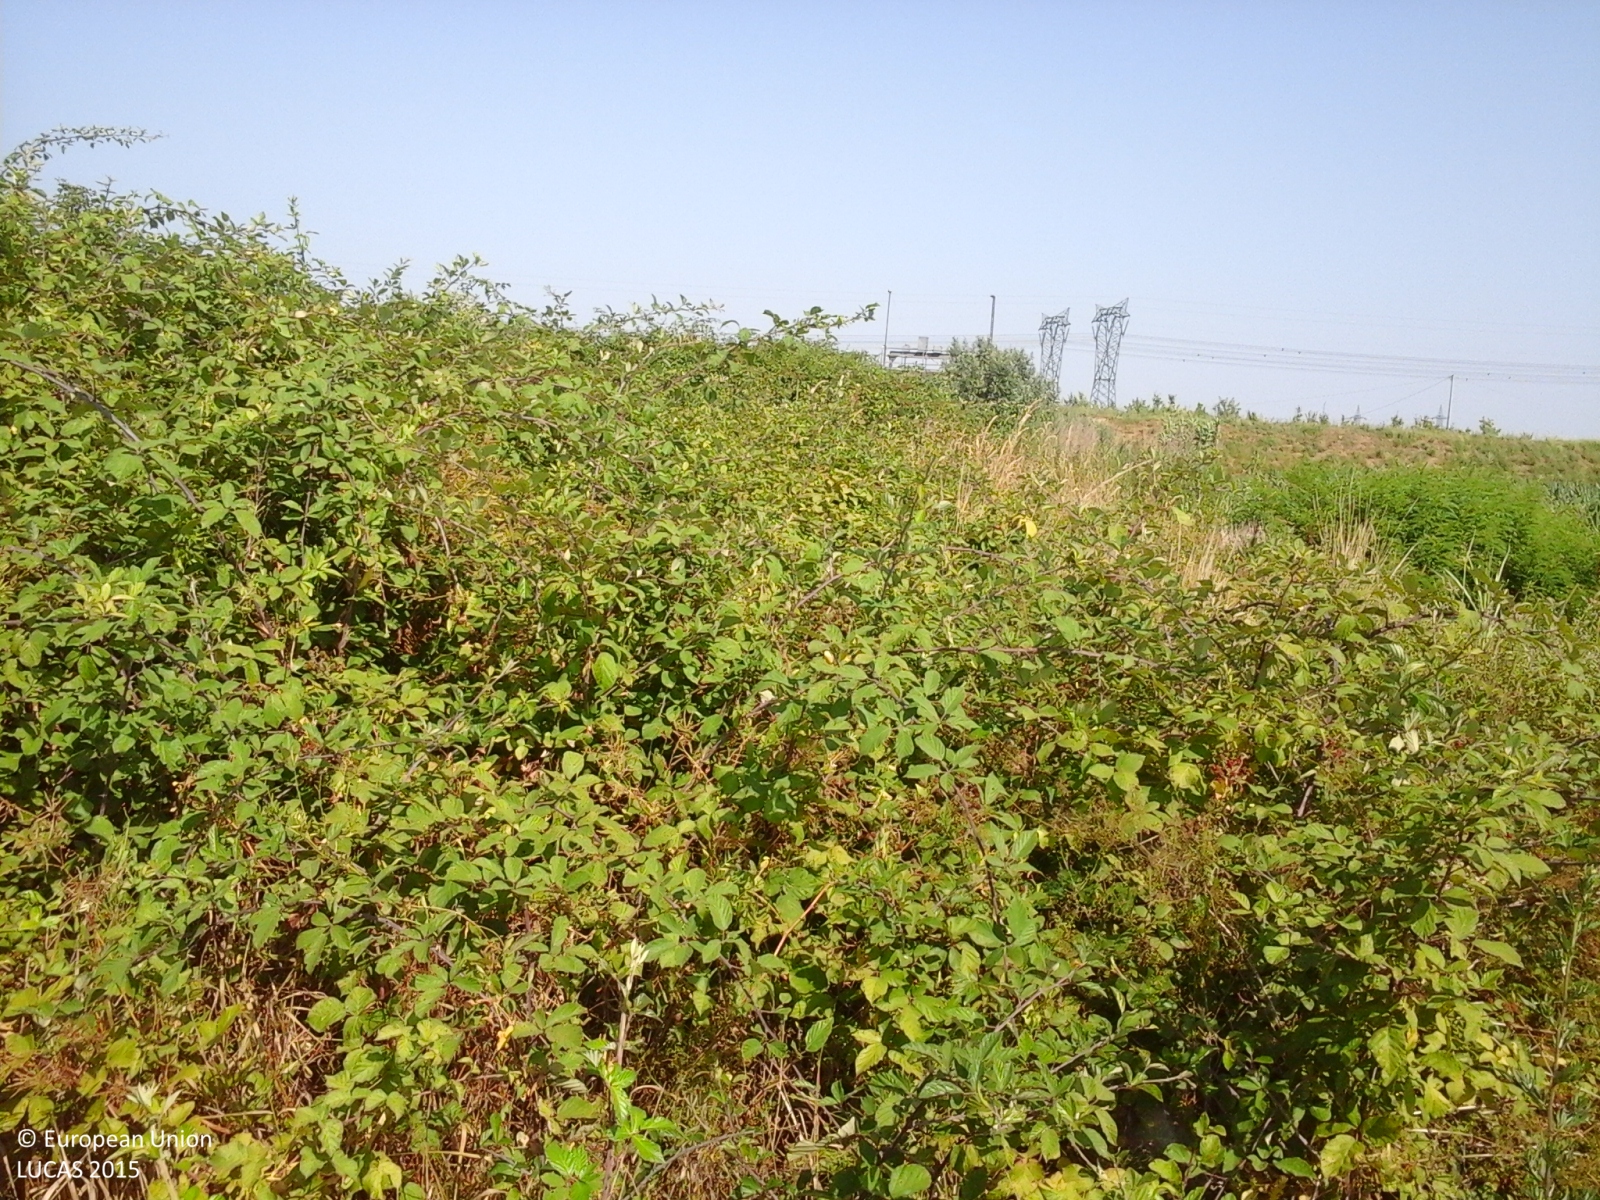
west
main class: Grassland
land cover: Spontaneously vegetated surfaces
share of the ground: > 75 %
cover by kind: herbaceous plants 100 %
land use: Fallow land
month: July
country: IT
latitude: 43.8403
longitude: 11.0297
